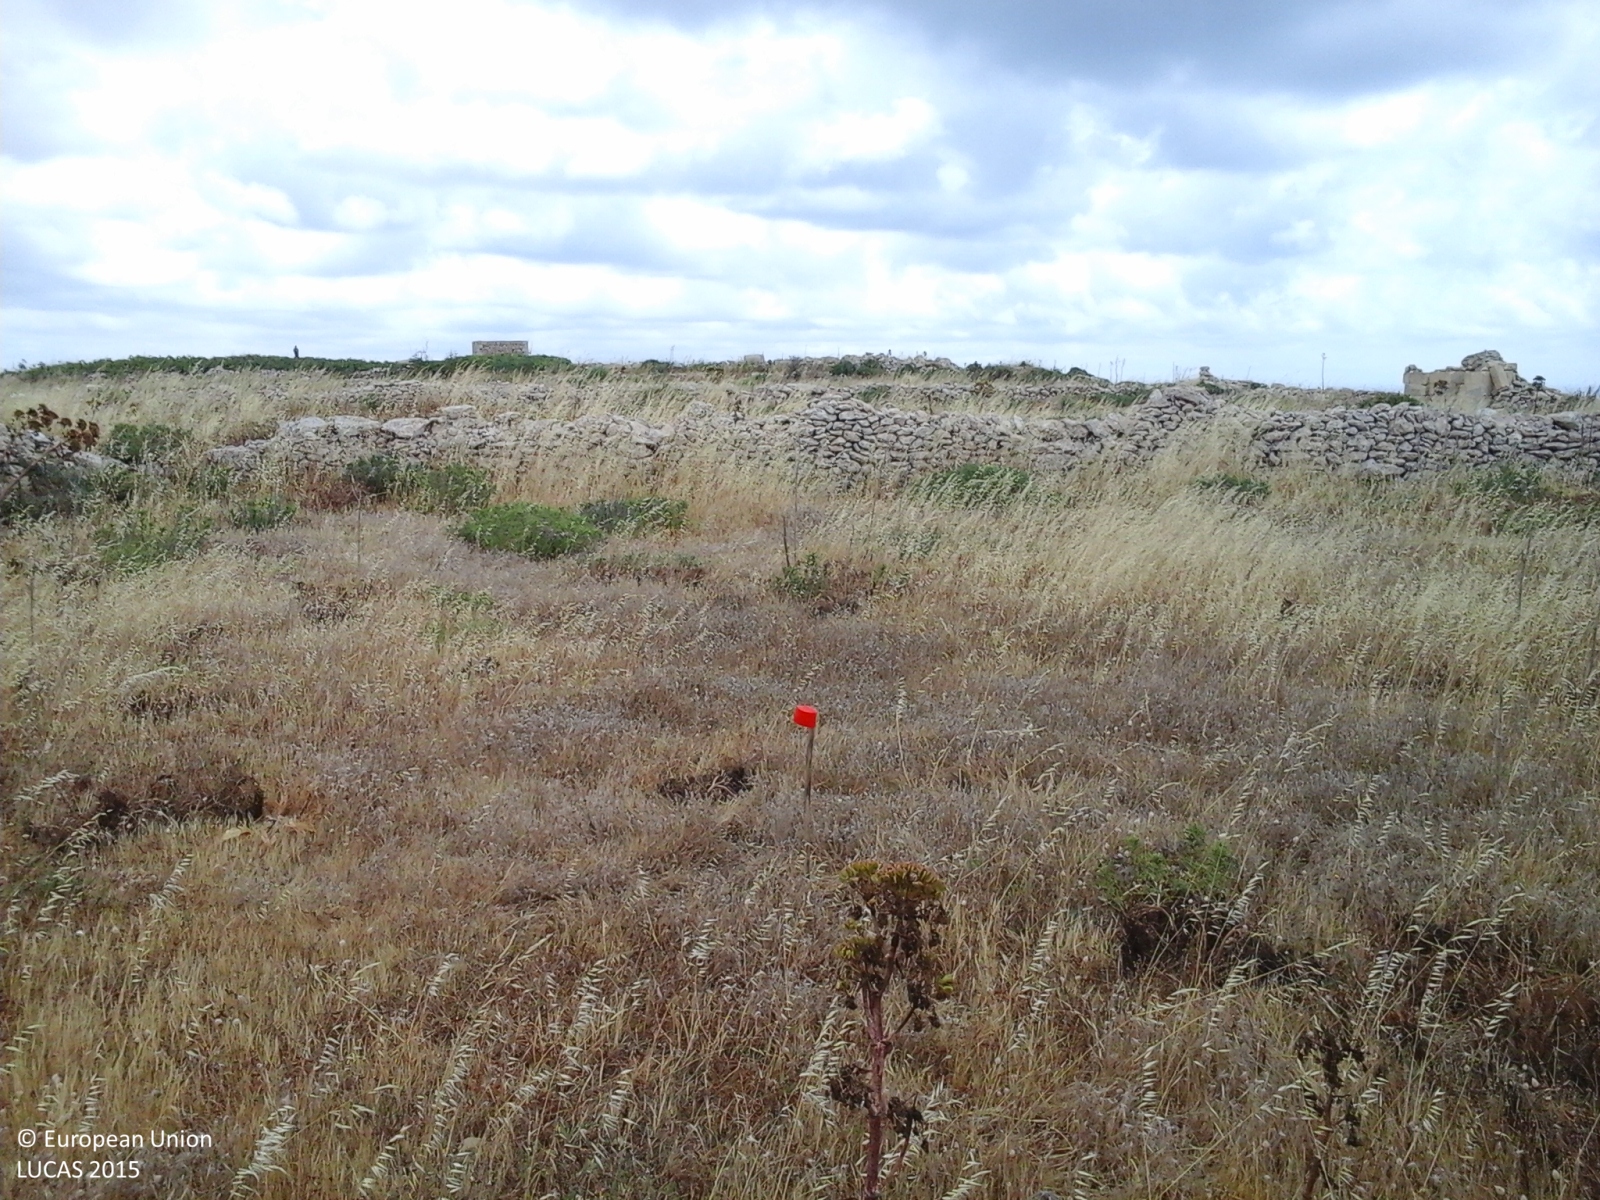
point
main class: Grassland
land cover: Grassland without tree/shrub cover
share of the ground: > 75 %
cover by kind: herbaceous plants 95 %
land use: Abandoned areas
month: May
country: MT
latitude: 36.0360
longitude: 14.1902
